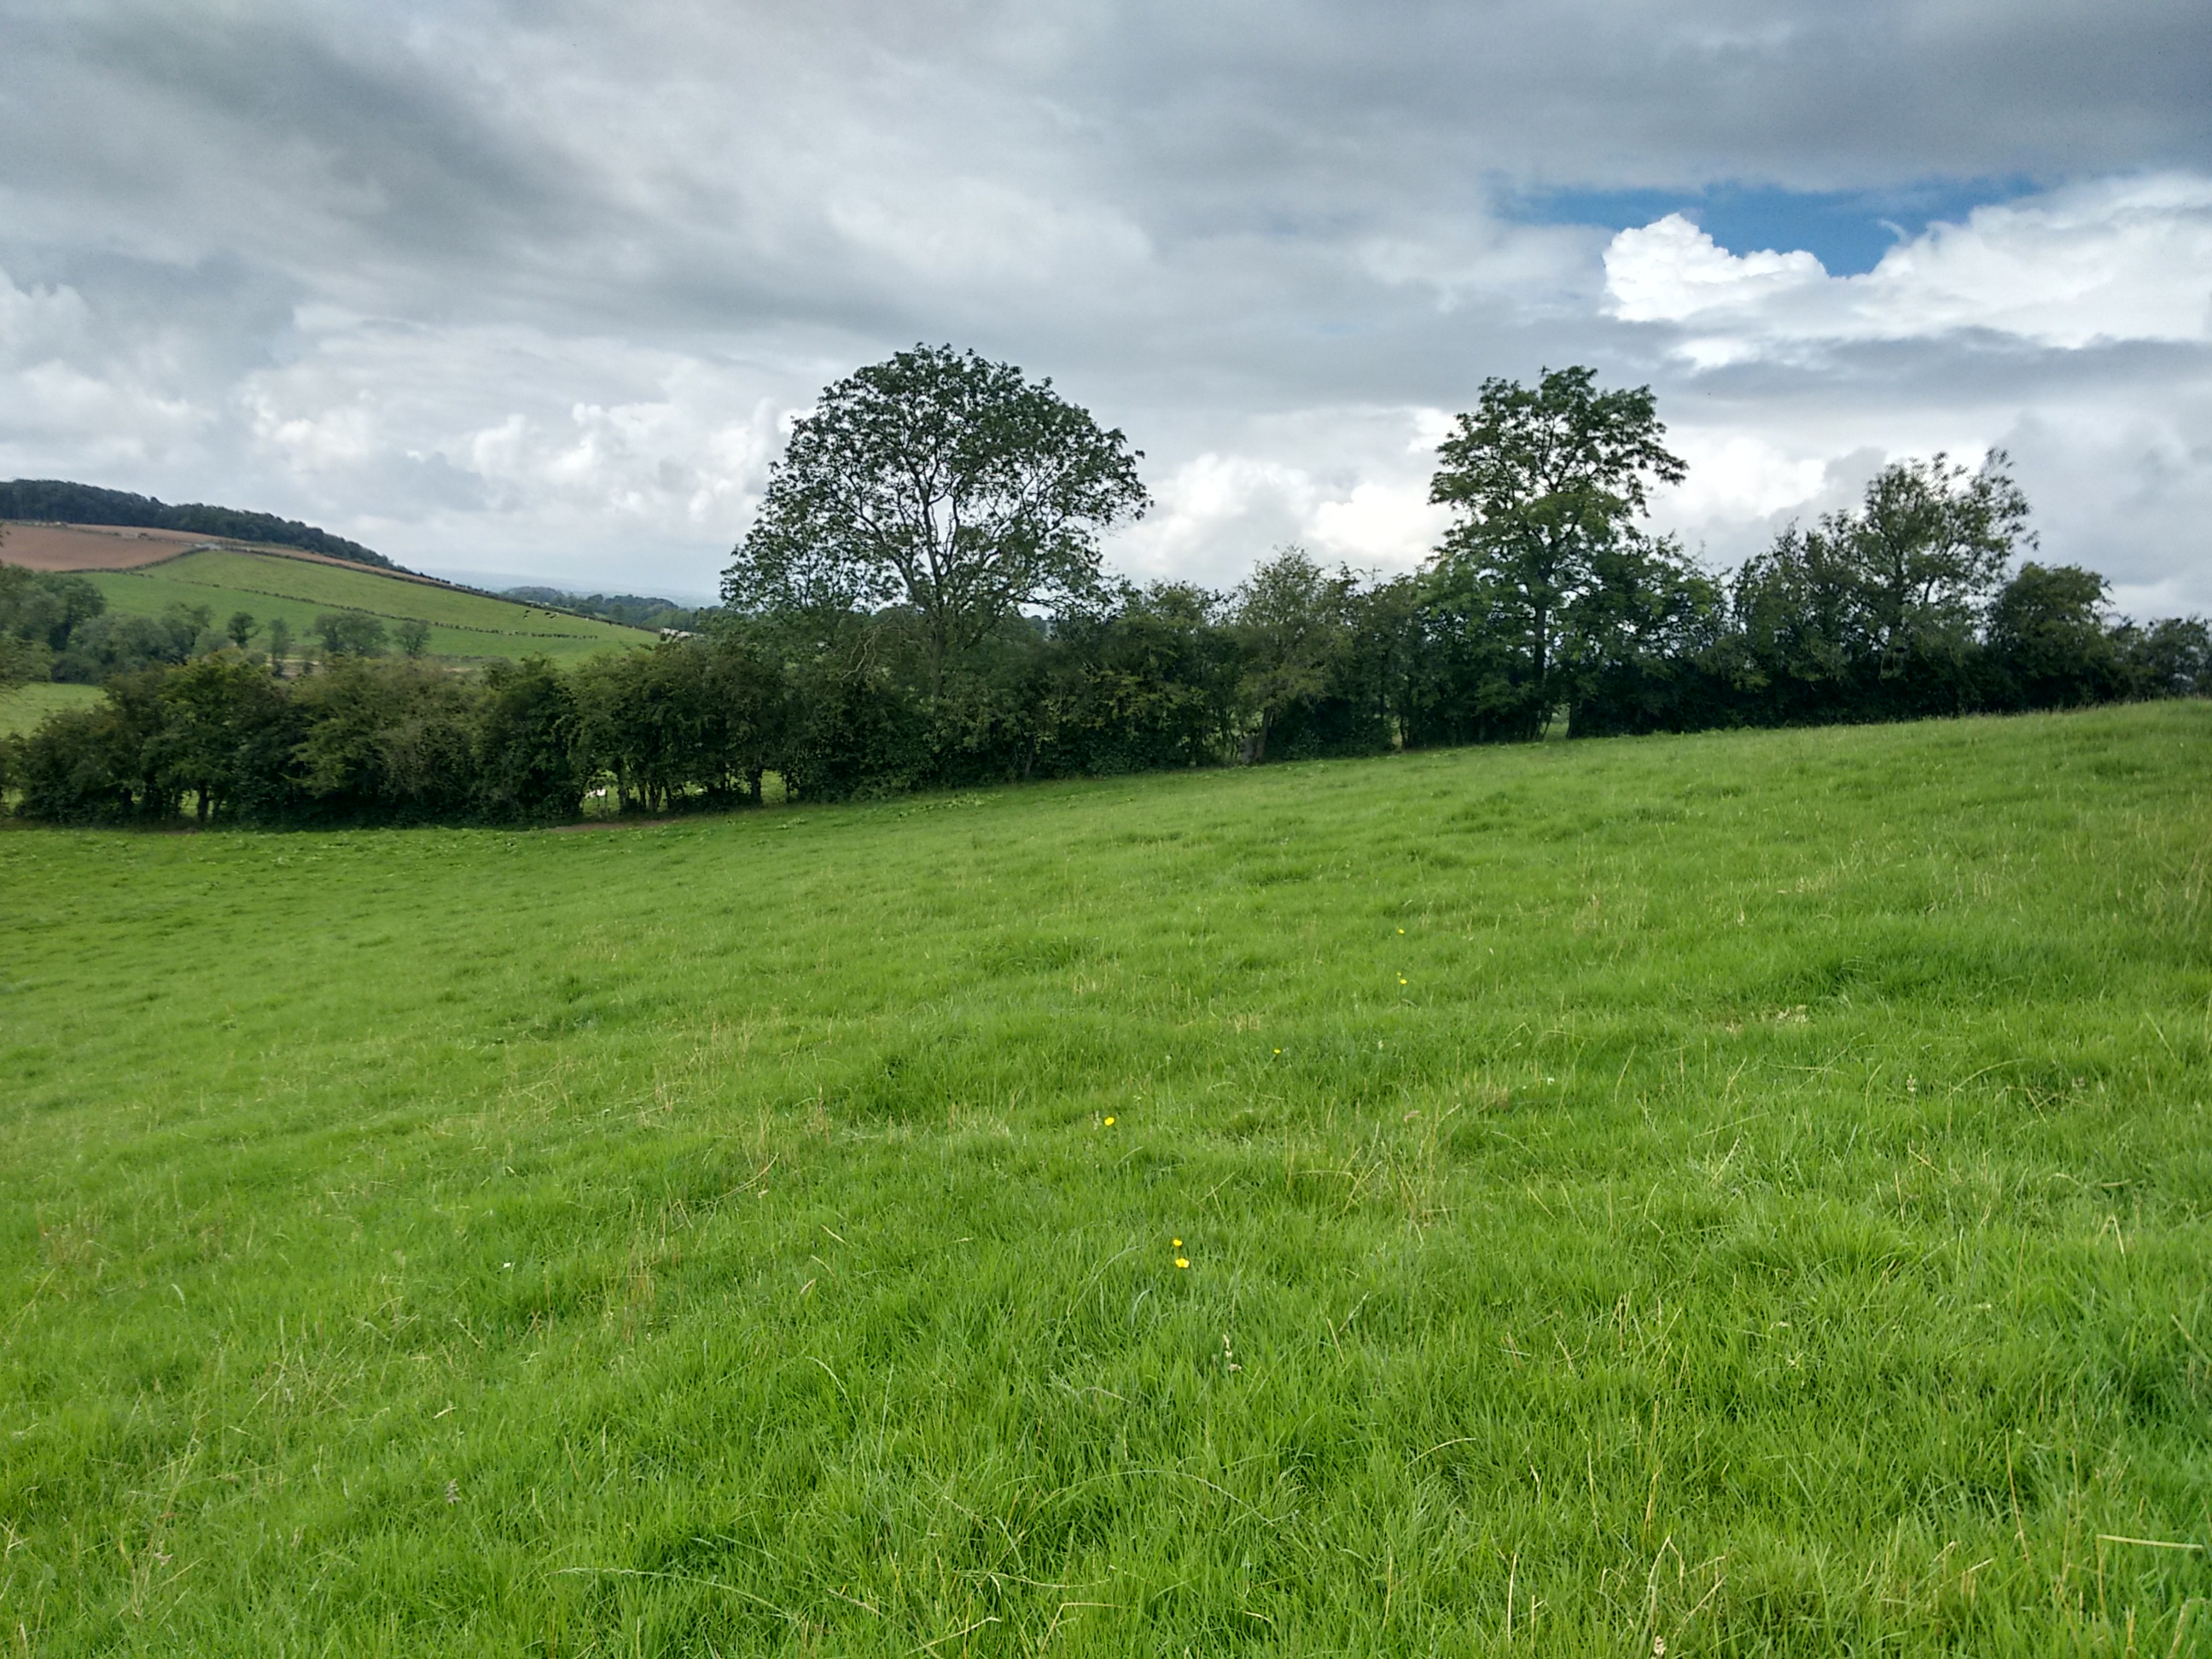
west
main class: Grassland
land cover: Grassland without tree/shrub cover
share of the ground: > 75 %
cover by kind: herbaceous plants 100 %
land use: Agriculture (excluding fallow land and kitchen gardens)
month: August
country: GB
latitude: 54.3769
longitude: -6.8704
